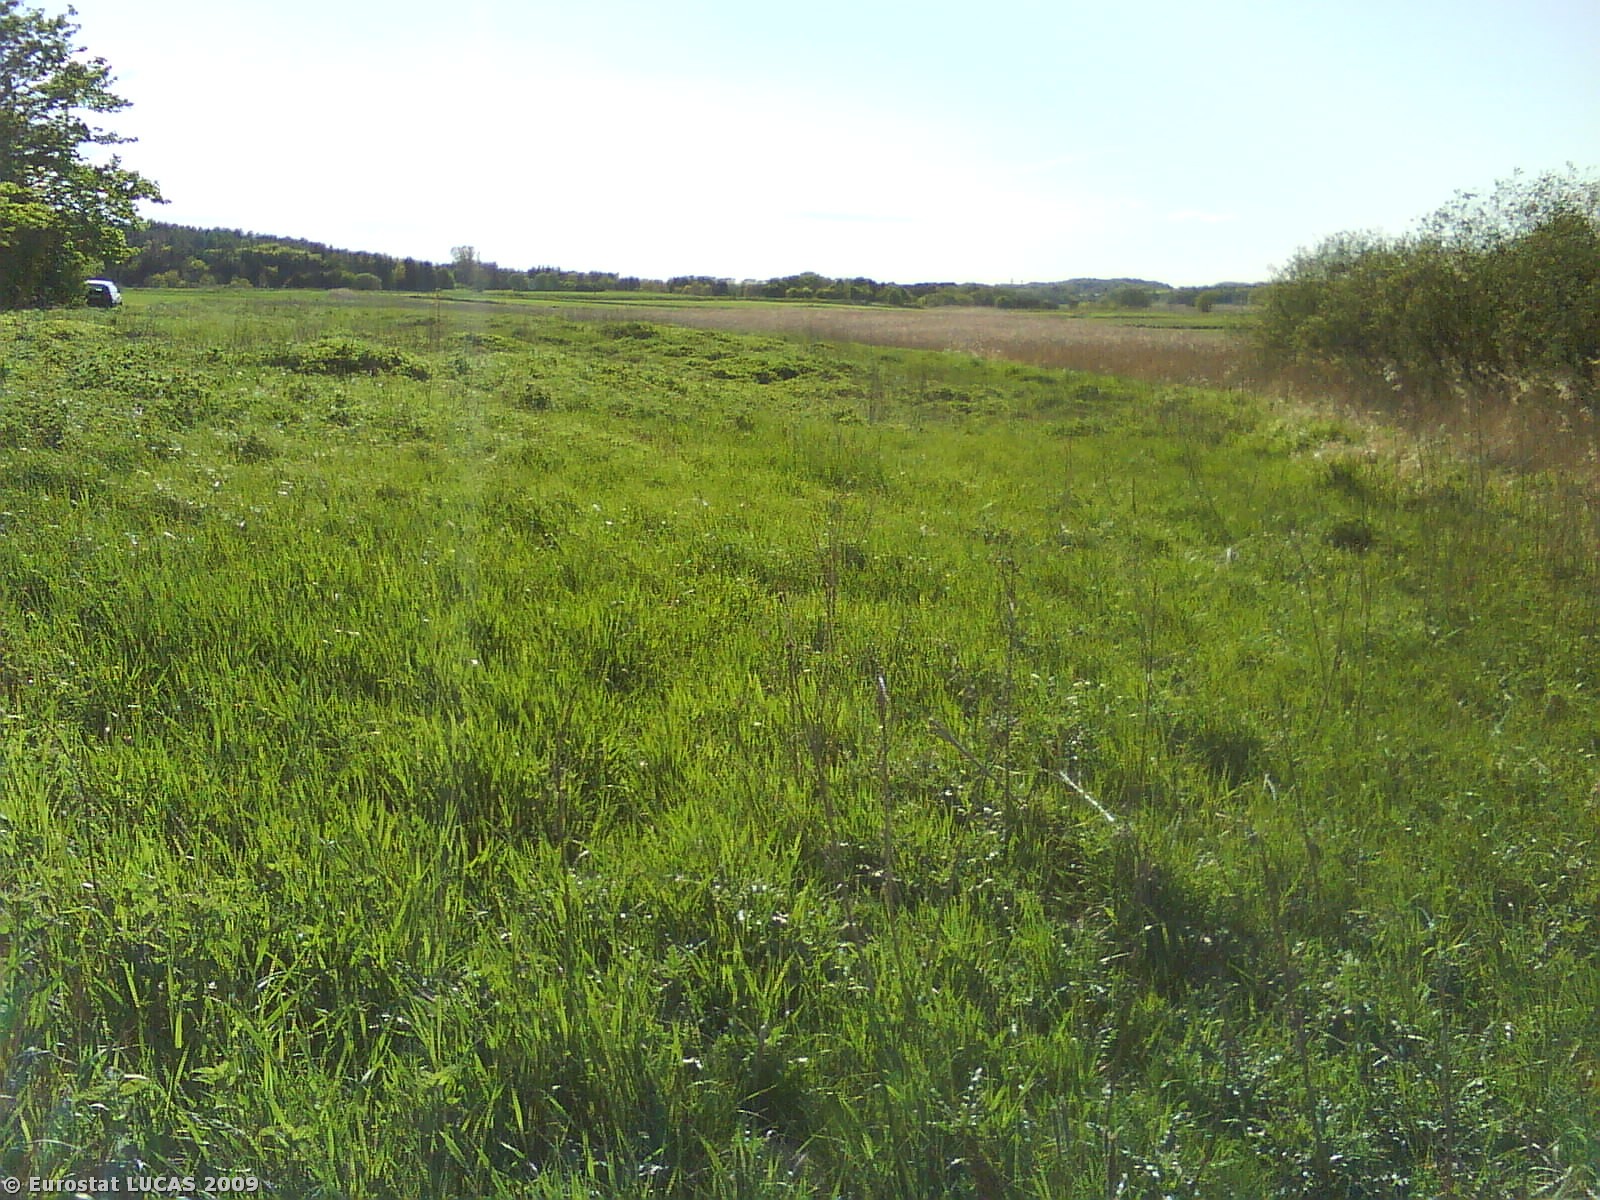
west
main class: Grassland
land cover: Grassland without tree/shrub cover
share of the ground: > 75 %
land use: Unused
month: May
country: DK
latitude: 56.4012
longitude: 10.7606
